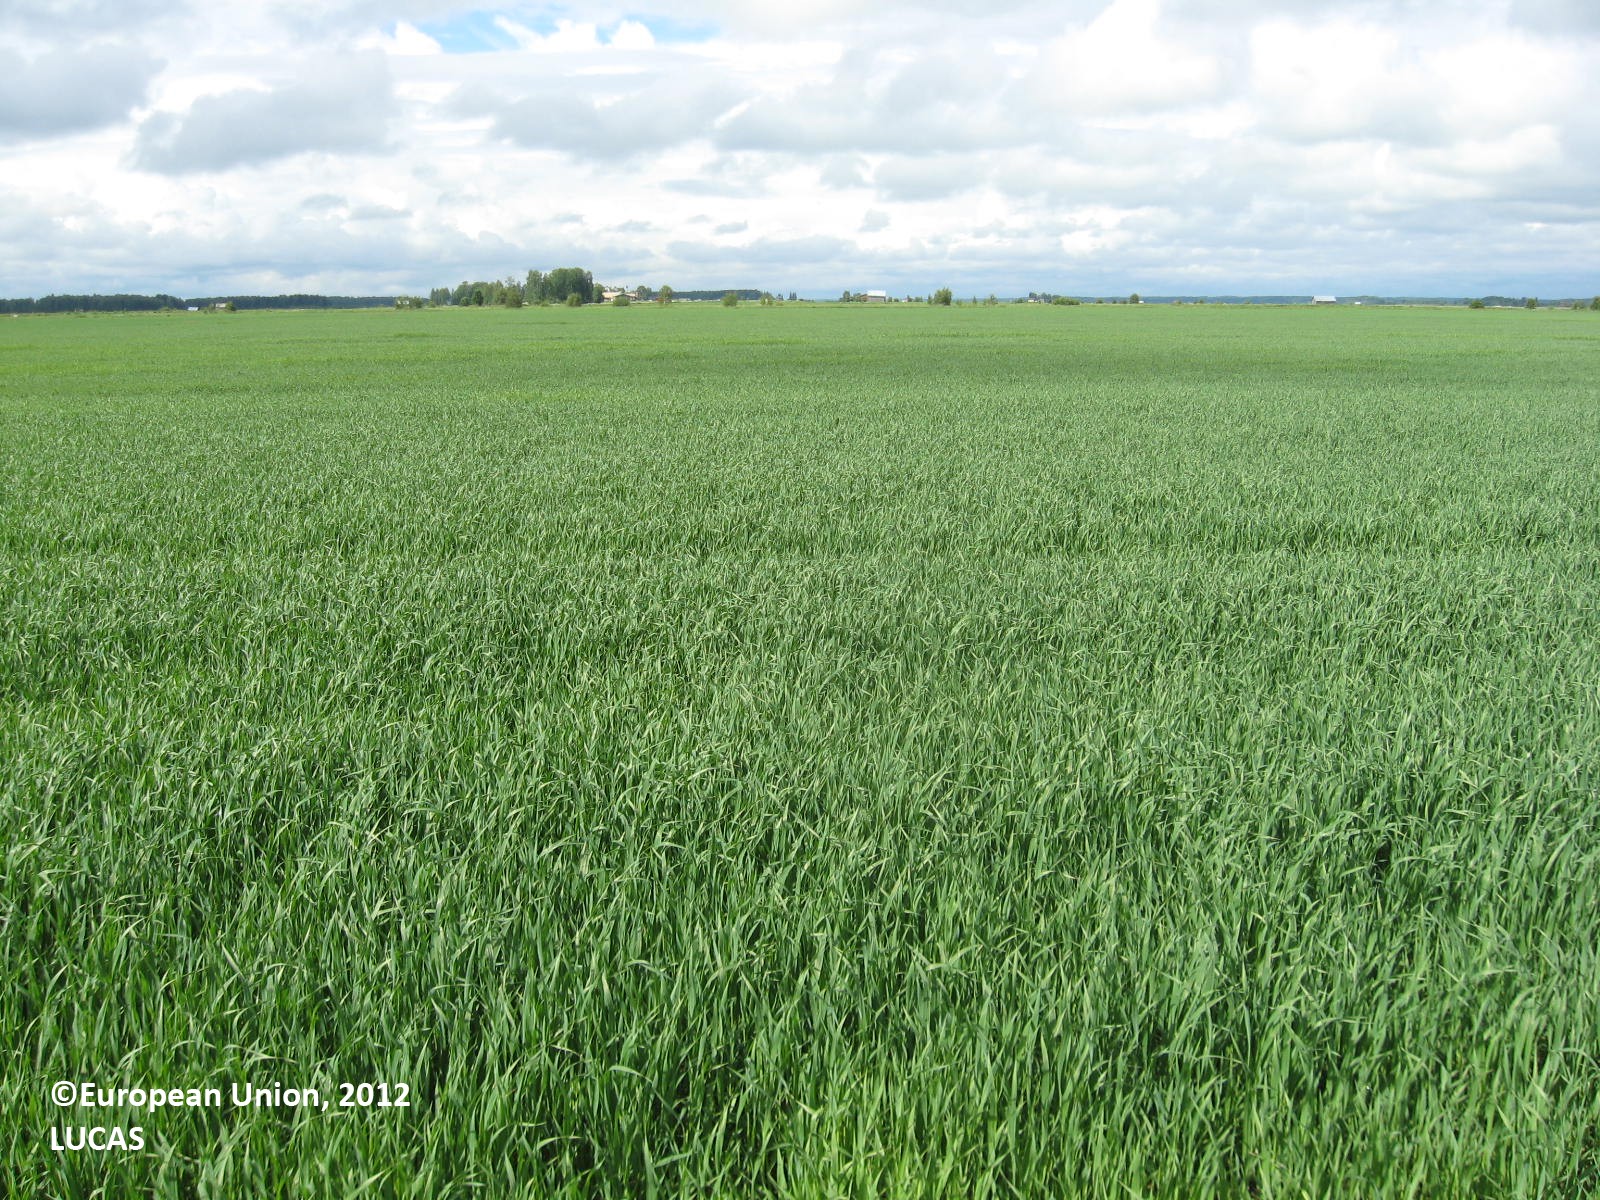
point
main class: Cropland
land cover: Oats
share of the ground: > 75 %
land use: Agriculture (excluding fallow land and kitchen gardens)
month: June
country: FI
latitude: 63.0271
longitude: 22.8822
